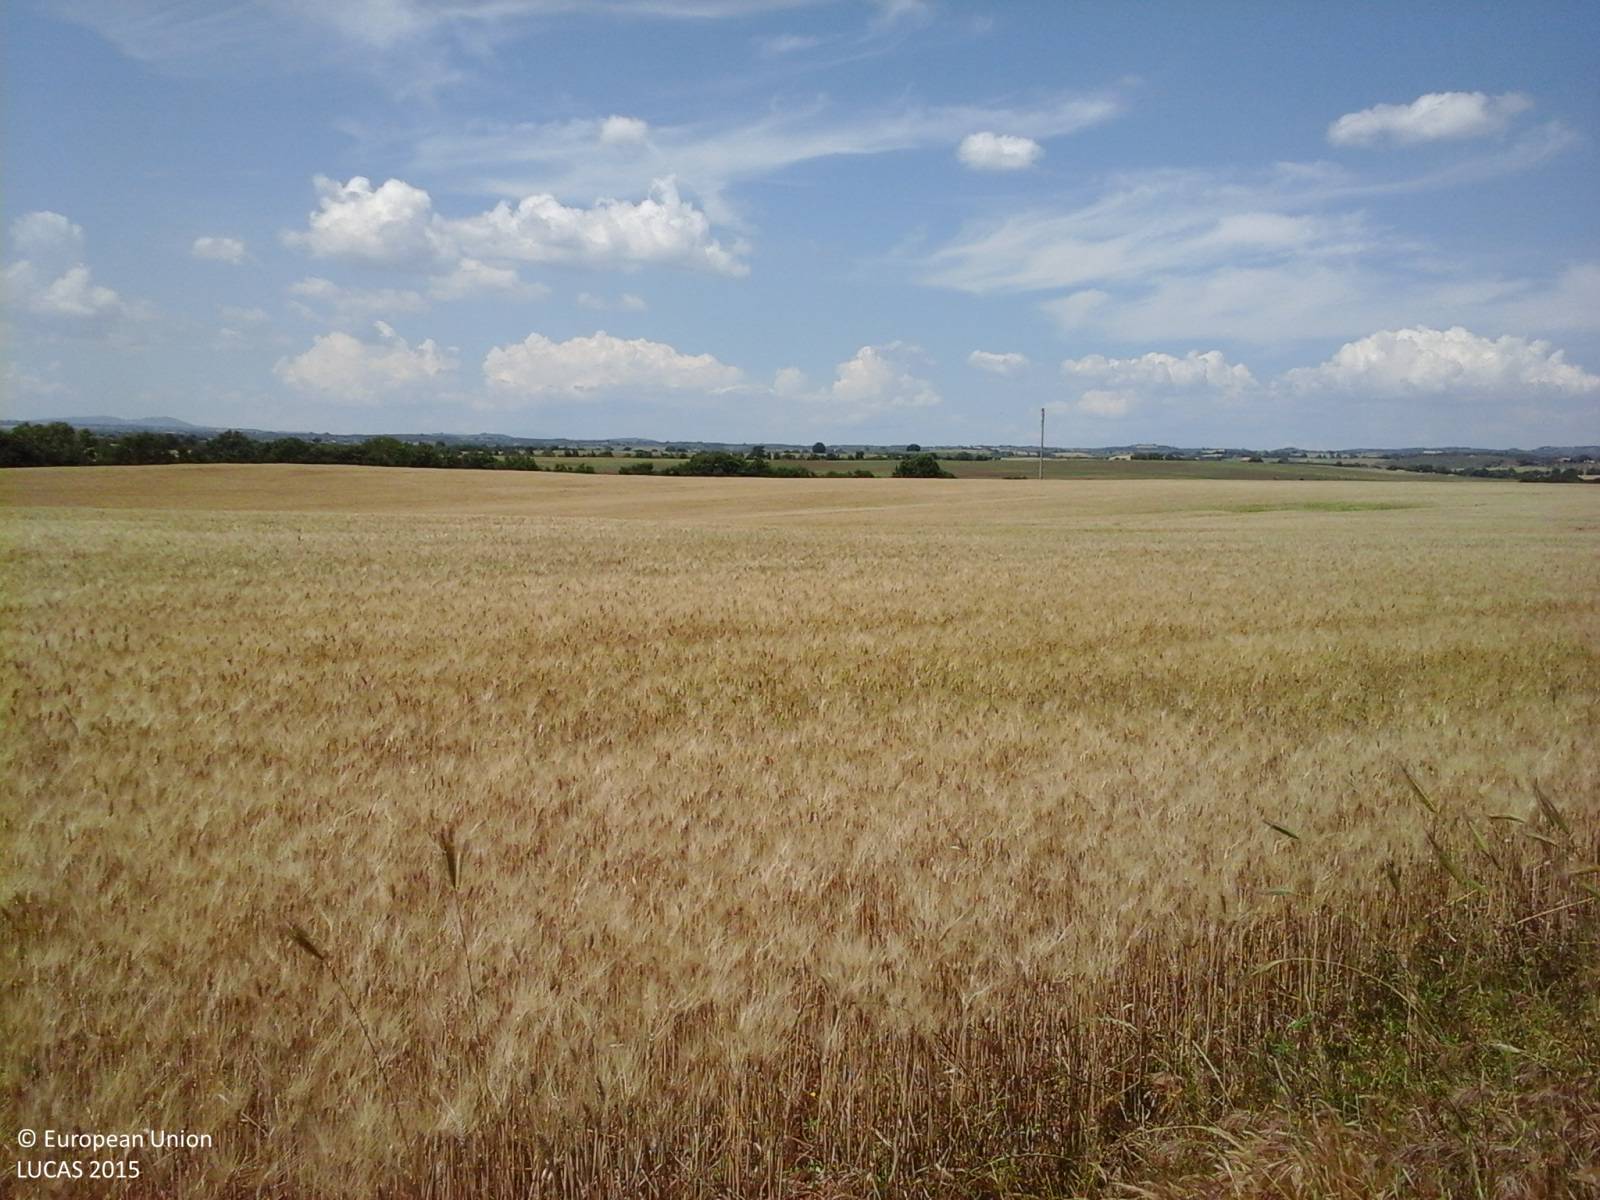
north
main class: Cropland
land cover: Durum wheat
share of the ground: > 75 %
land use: Agriculture (excluding fallow land and kitchen gardens)
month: June
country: IT
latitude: 42.4360
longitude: 11.9747
